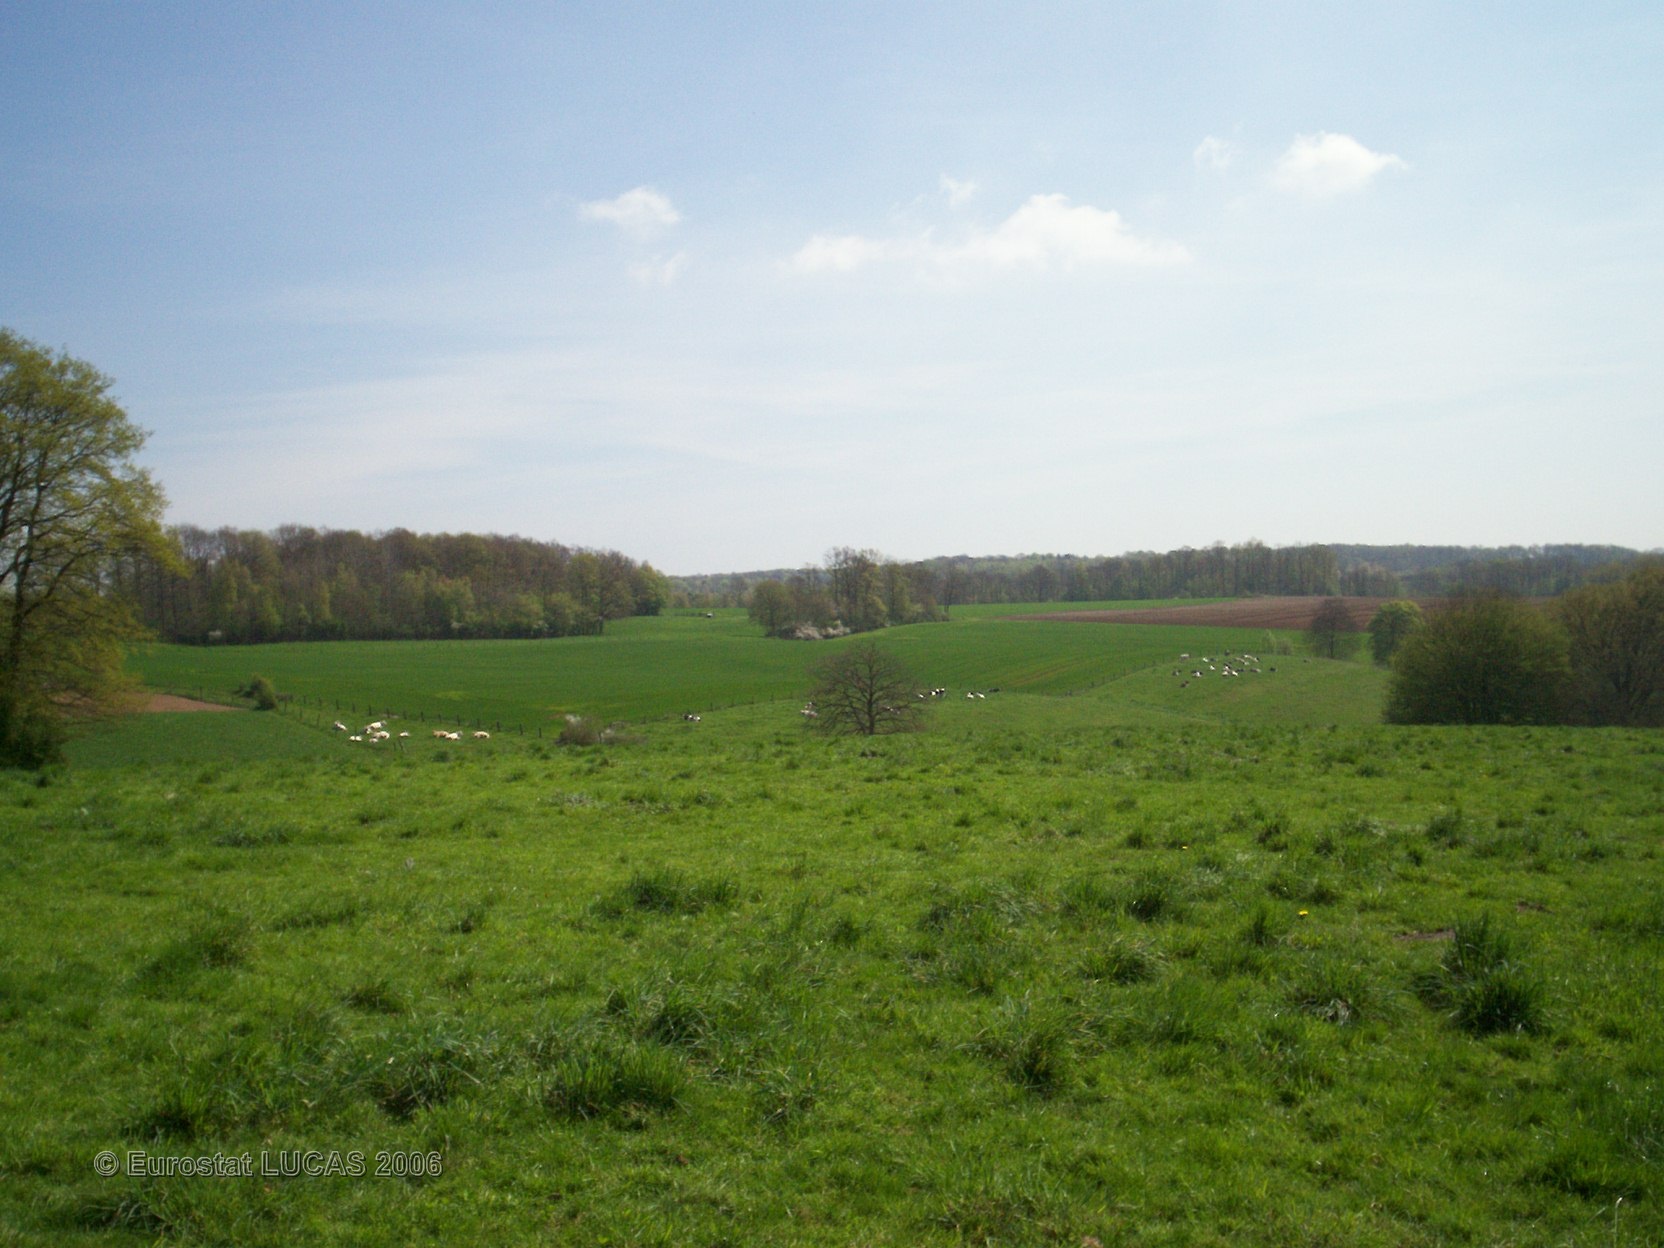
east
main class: Grassland
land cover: Grassland without tree/shrub cover
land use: Agriculture (excluding fallow land and kitchen gardens)
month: April
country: FR
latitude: 49.6508
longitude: 4.4141
